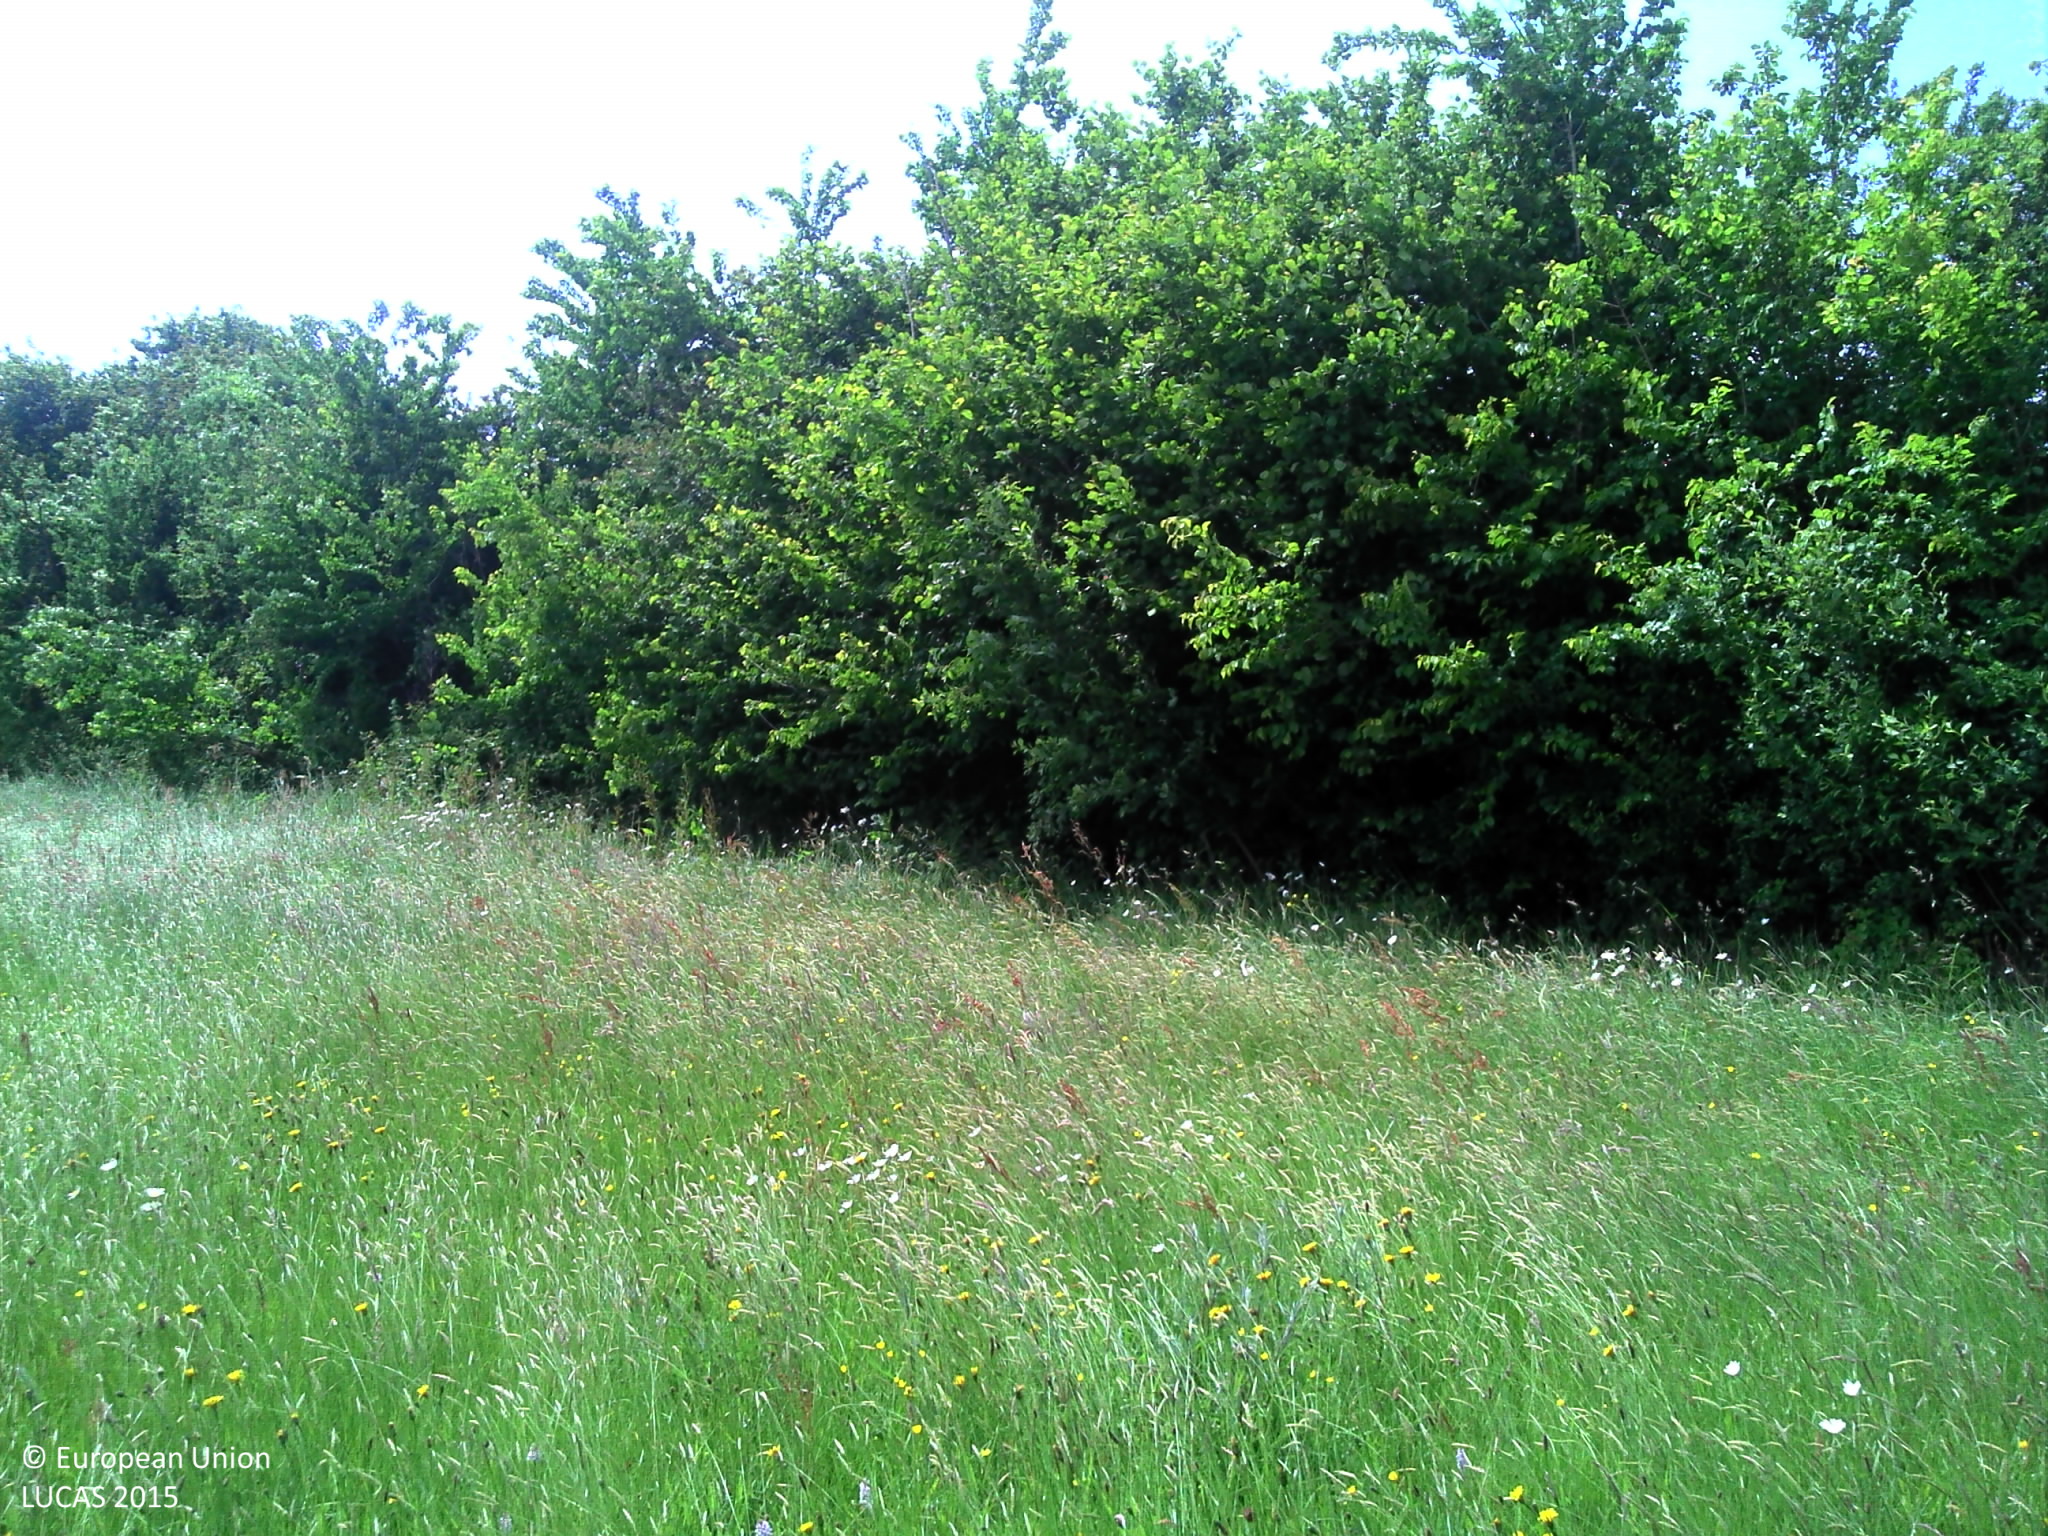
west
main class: Grassland
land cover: Grassland without tree/shrub cover
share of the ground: > 75 %
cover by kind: herbaceous plants 100 %
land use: Agriculture (excluding fallow land and kitchen gardens)
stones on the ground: < 10 %
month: June
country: FR
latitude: 49.4945
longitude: -1.4669
